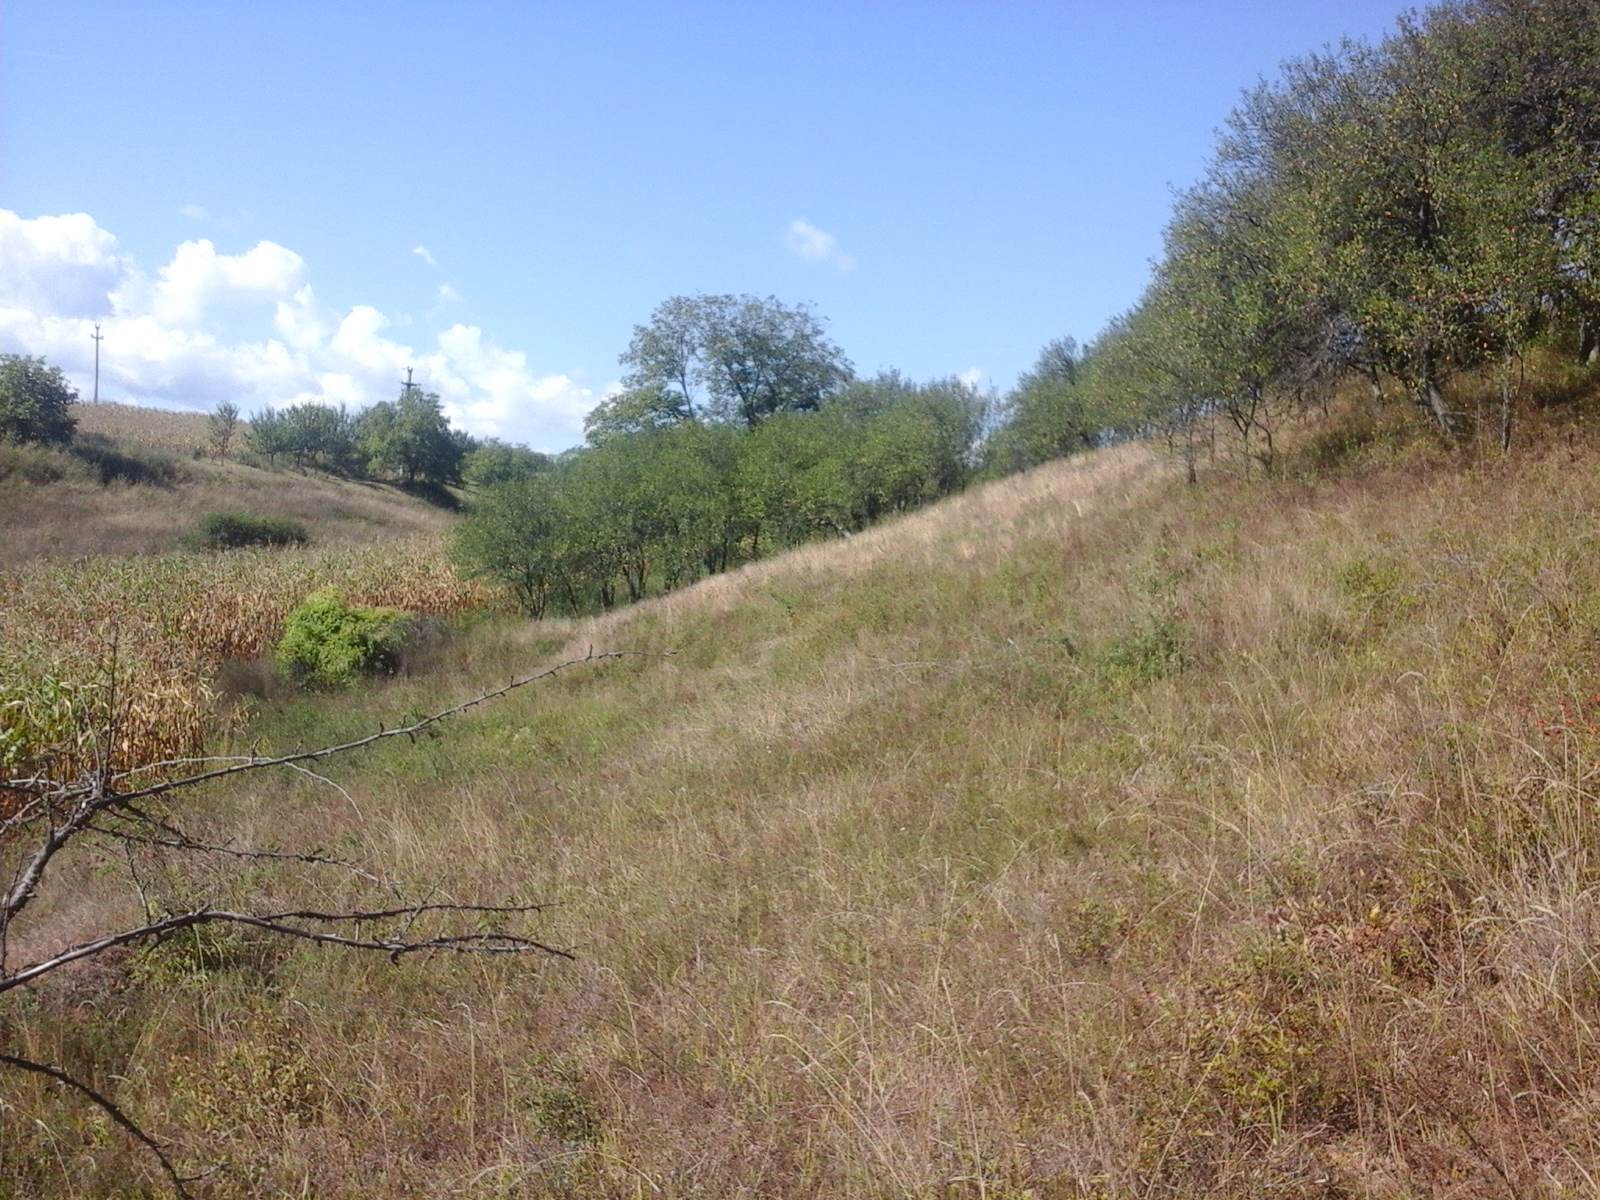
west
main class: Grassland
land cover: Spontaneously vegetated surfaces
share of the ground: > 75 %
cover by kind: herbaceous plants 100 %
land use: Fallow land
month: September
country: RO
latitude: 47.3939
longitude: 23.6019
